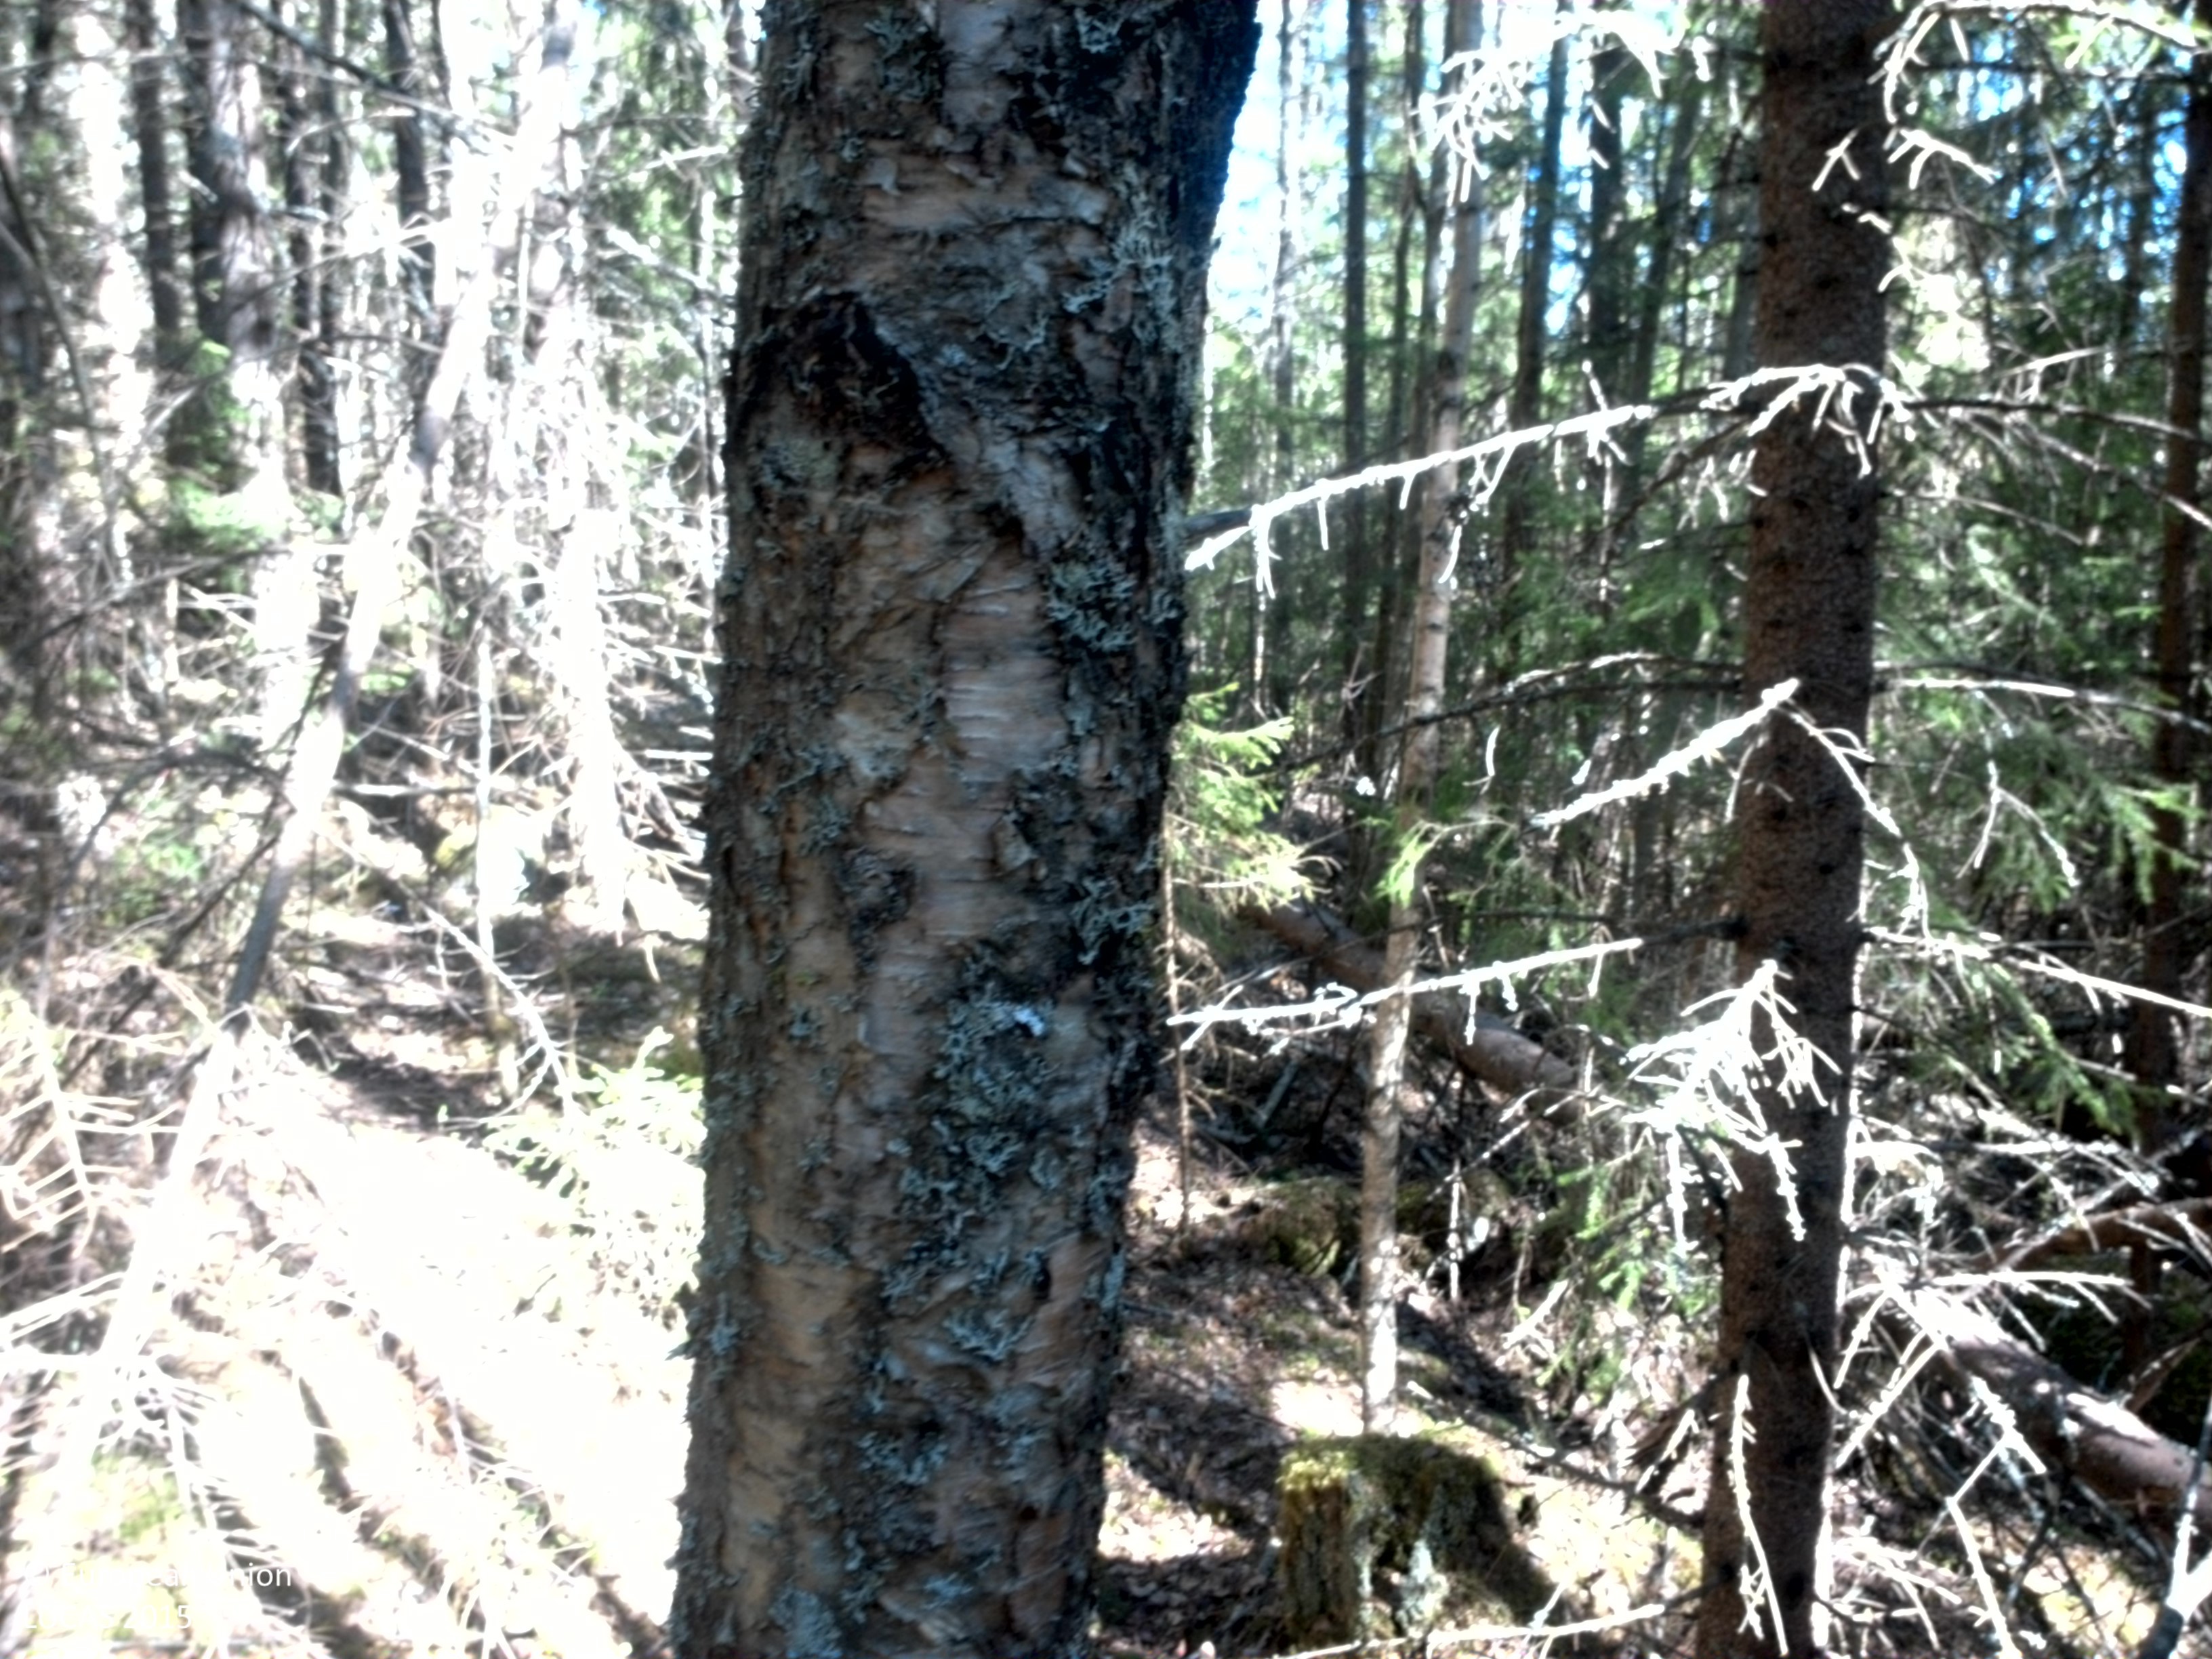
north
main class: Woodland
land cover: Spruce dominated coniferous woodland
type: boreal forest
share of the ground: > 75 %
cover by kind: coniferous forest trees 90 %, lichens and mosses 10 %
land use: Forestry
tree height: > 5 m
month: May
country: SE
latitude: 63.0155
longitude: 17.6617
